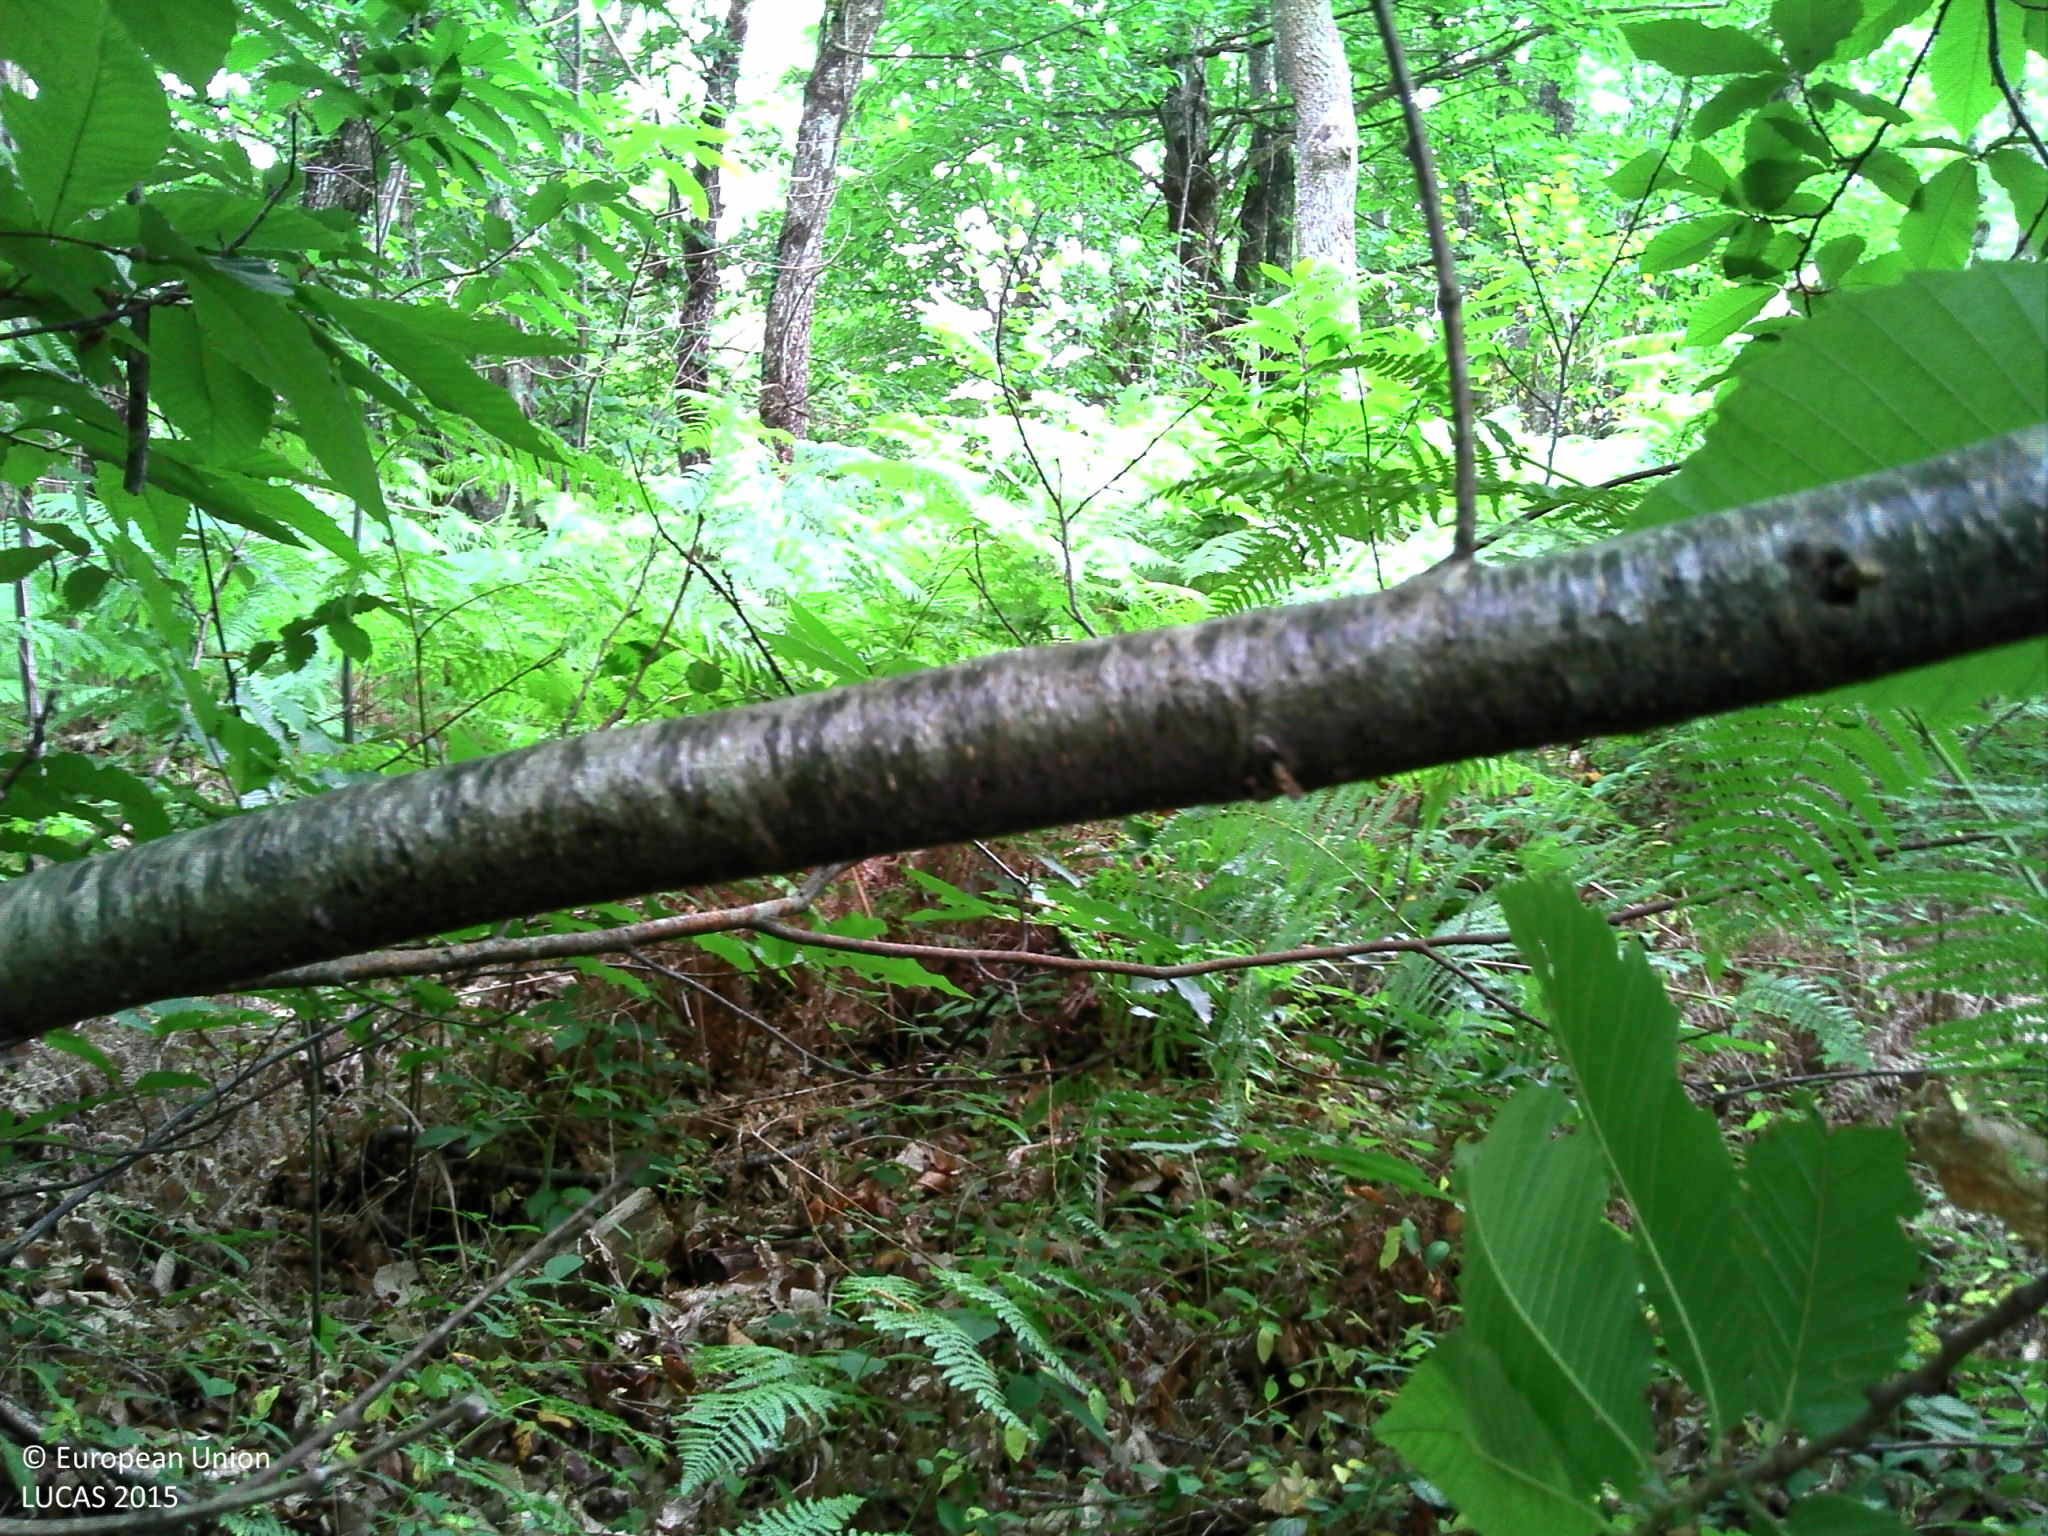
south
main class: Woodland
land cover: Broadleaved woodland
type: thermophilous deciduous forest
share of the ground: > 75 %
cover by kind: broadleaved forest trees 80 %, herbaceous plants 15 %, shrubs 5 %
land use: Forestry
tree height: > 5 m
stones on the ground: 10 - 25 %
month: July
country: FR
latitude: 45.0978
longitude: 0.7525
